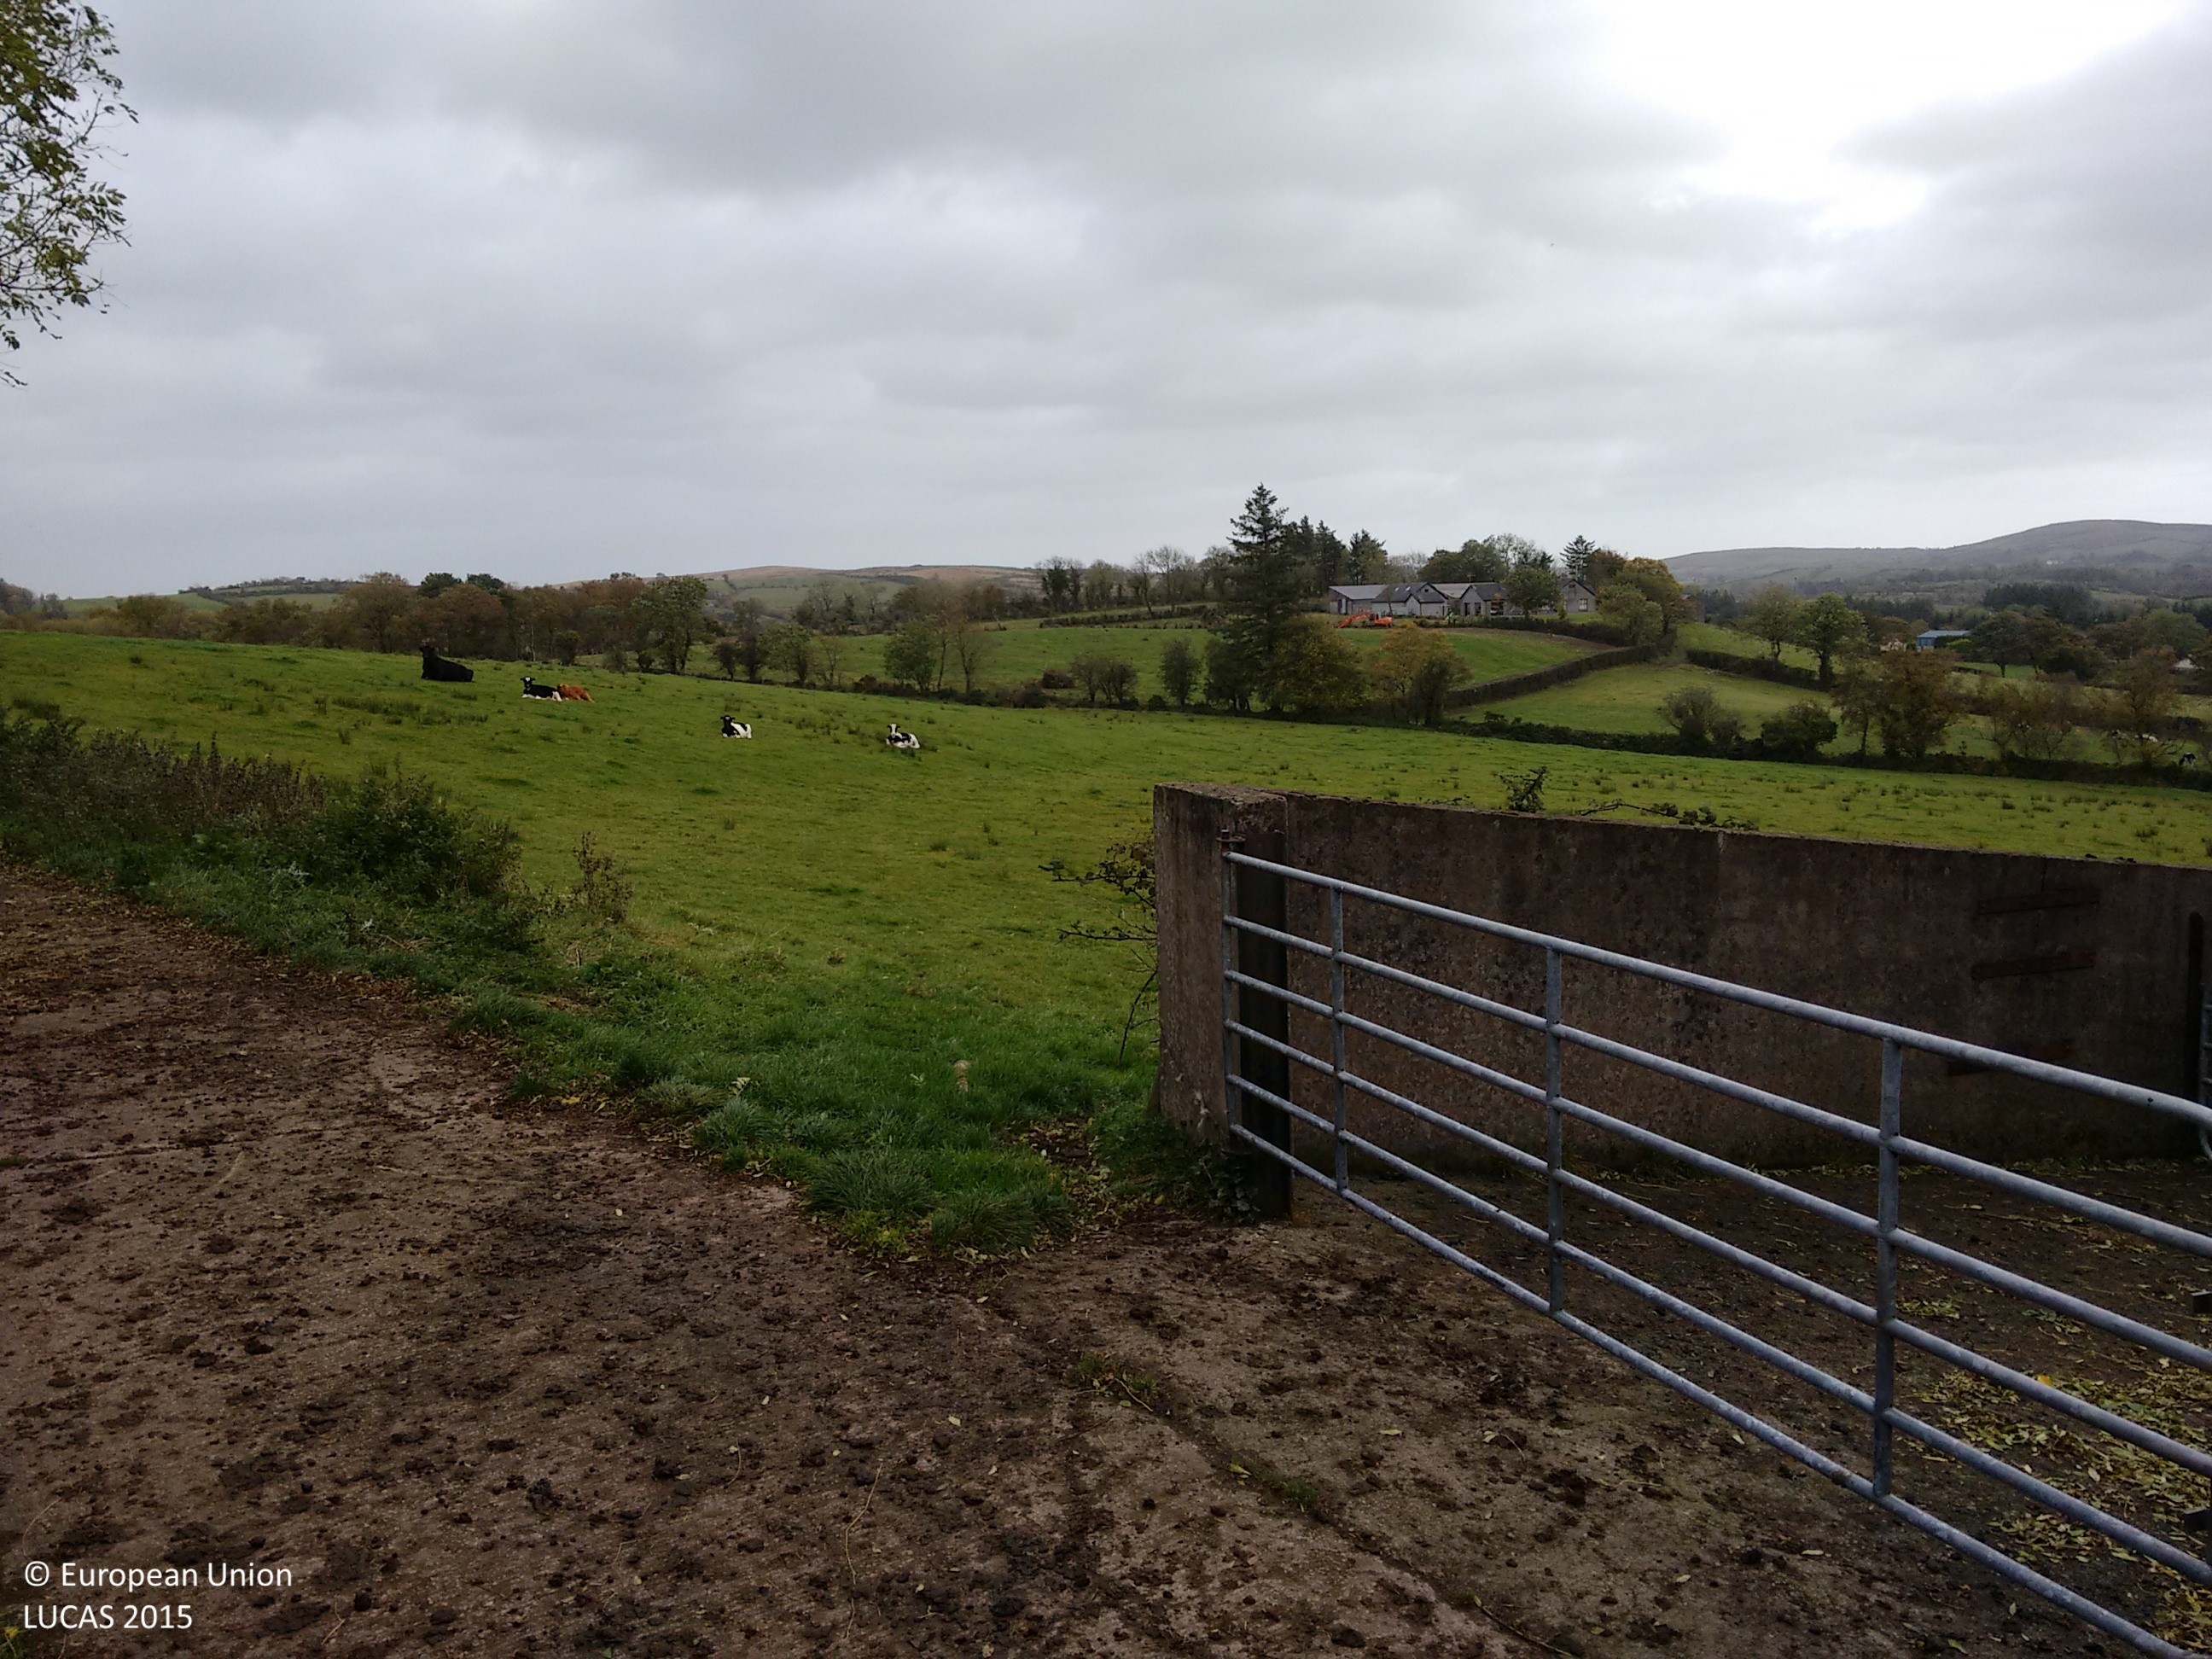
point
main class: Grassland
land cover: Grassland without tree/shrub cover
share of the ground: > 75 %
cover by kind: herbaceous plants 100 %
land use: Agriculture (excluding fallow land and kitchen gardens)
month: October
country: GB
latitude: 54.4570
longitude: -7.4777
